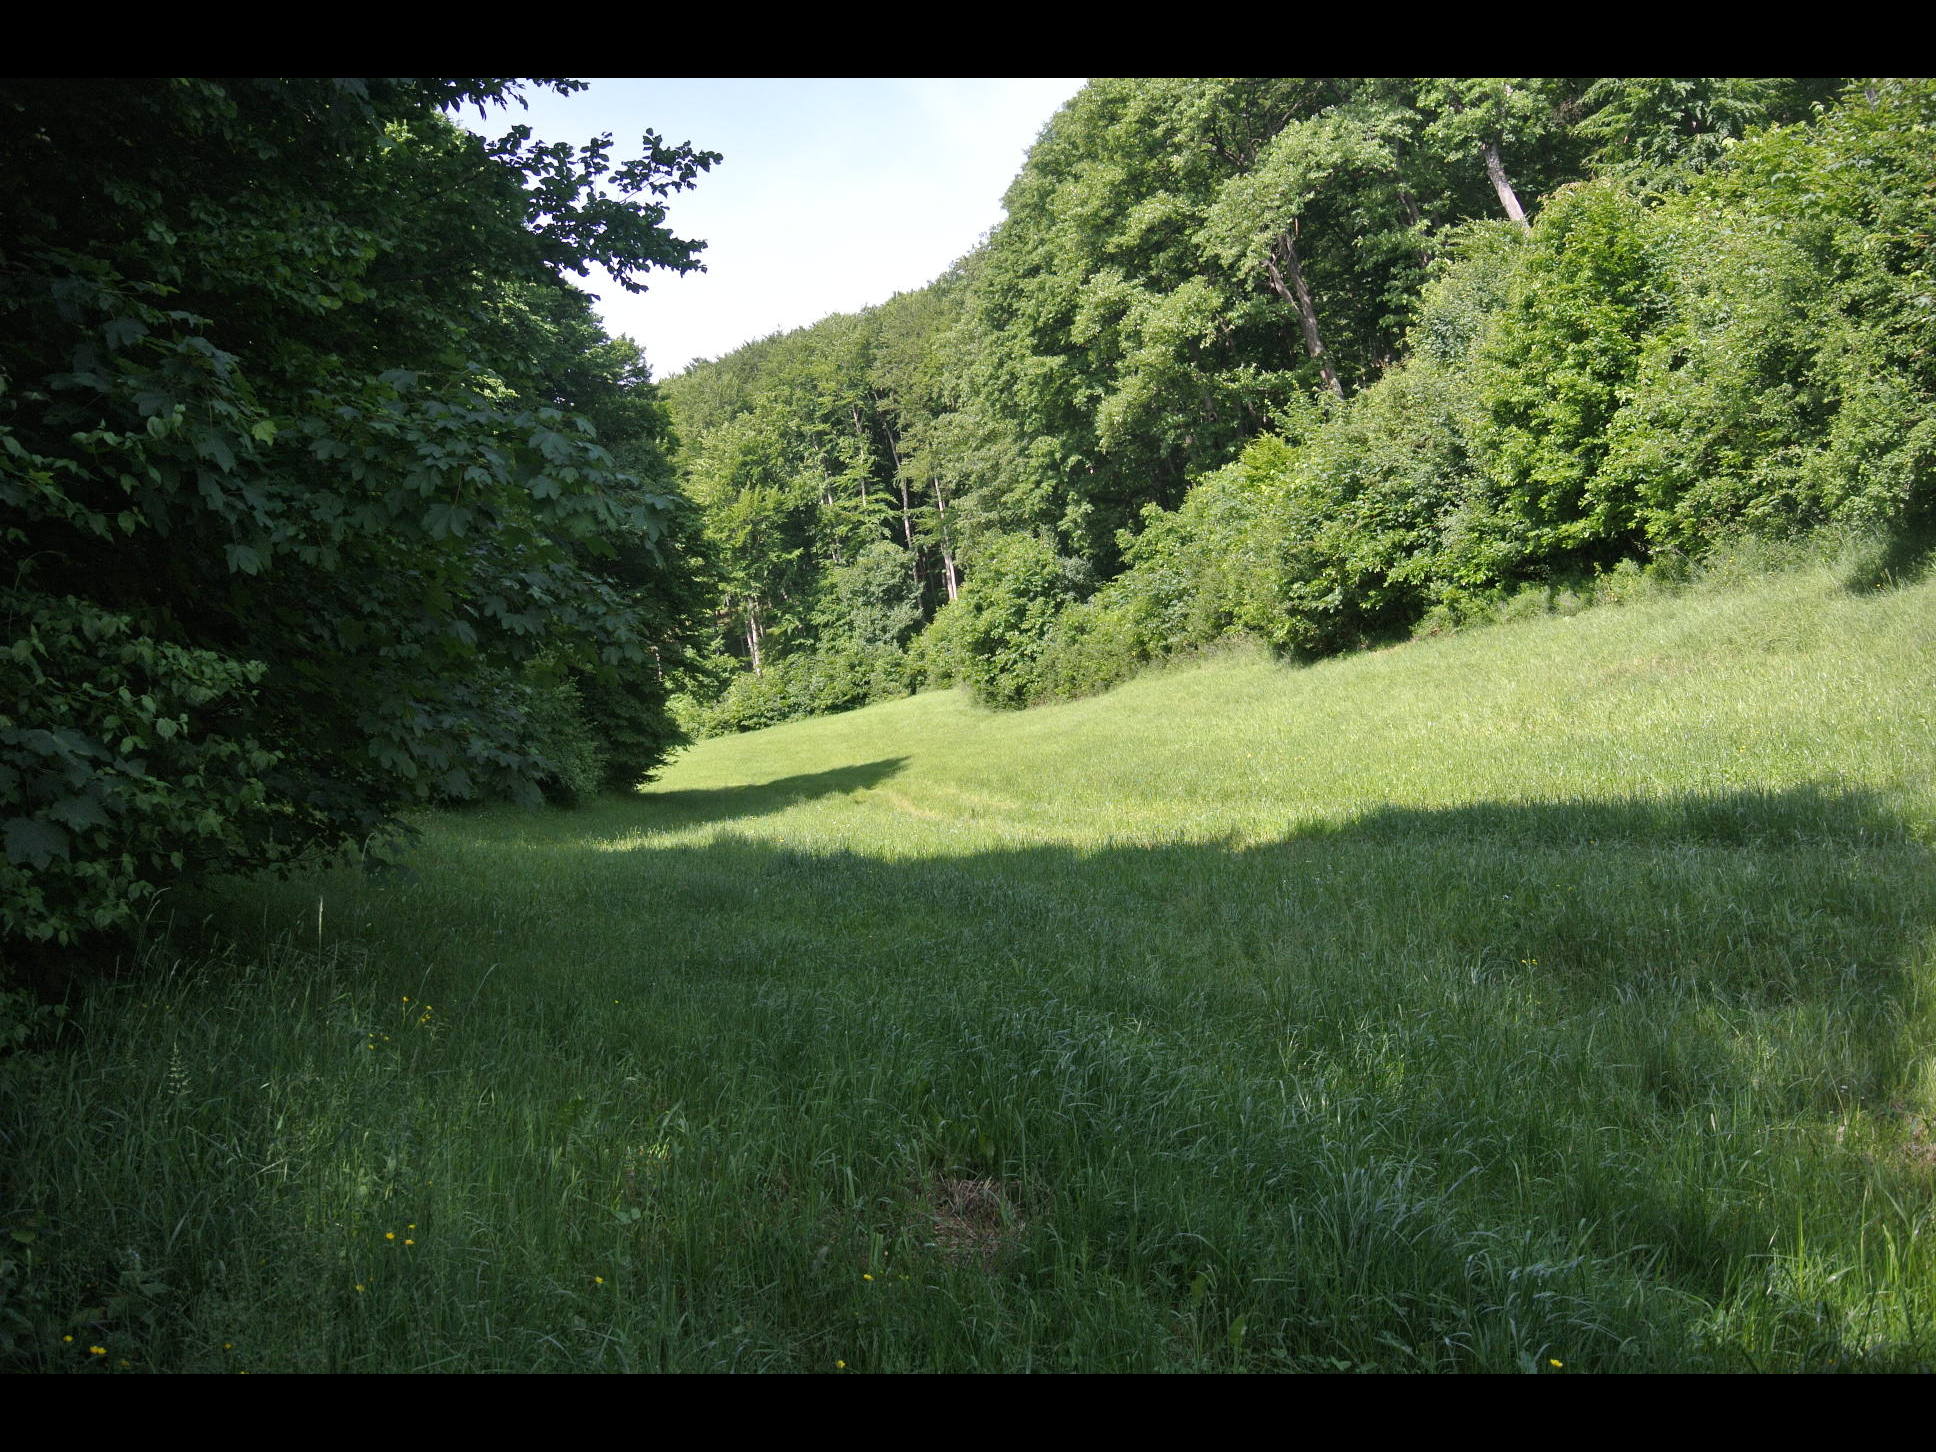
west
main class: Grassland
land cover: Grassland without tree/shrub cover
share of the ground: > 75 %
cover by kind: herbaceous plants 100 %
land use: Agriculture (excluding fallow land and kitchen gardens)
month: June
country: AT
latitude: 48.0571
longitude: 16.0548
